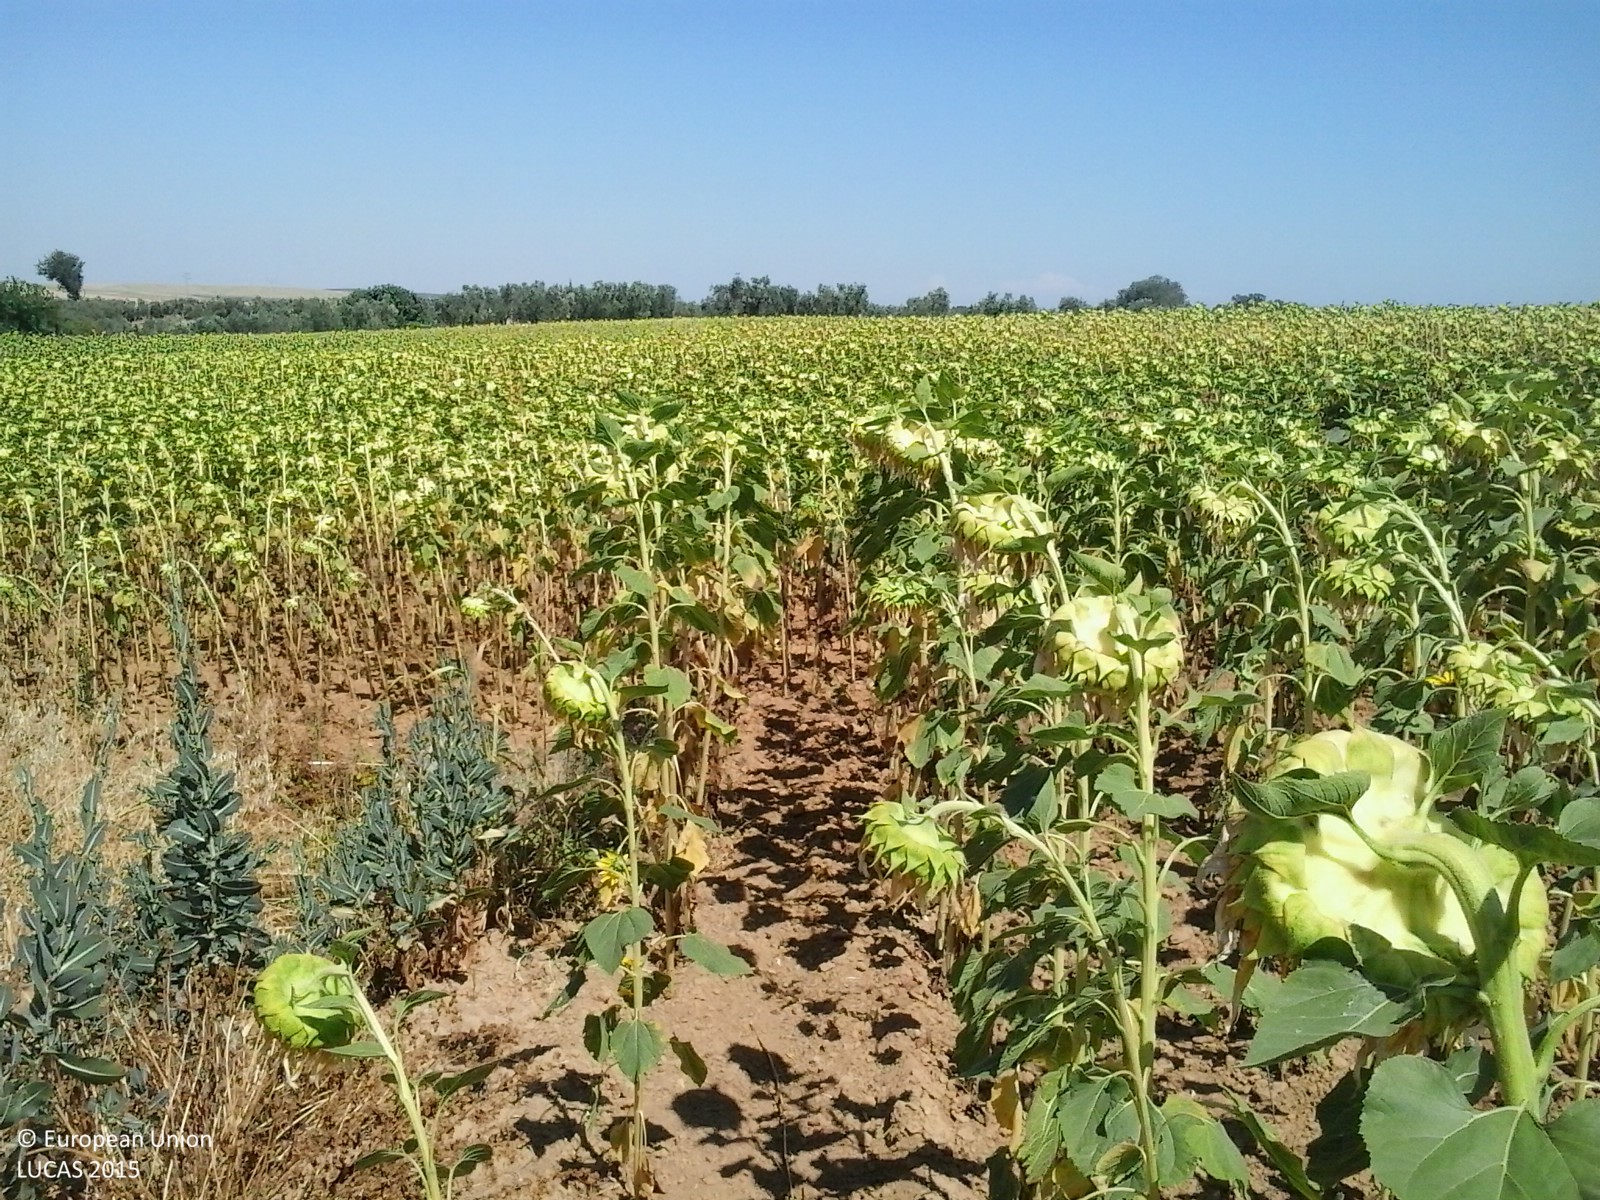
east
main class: Cropland
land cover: Sunflower
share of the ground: > 75 %
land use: Agriculture (excluding fallow land and kitchen gardens)
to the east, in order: Sunflower; Grass margins; Olive groves; Grass margins; Olive groves
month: June
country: ES
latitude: 37.3843
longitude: -6.3957
